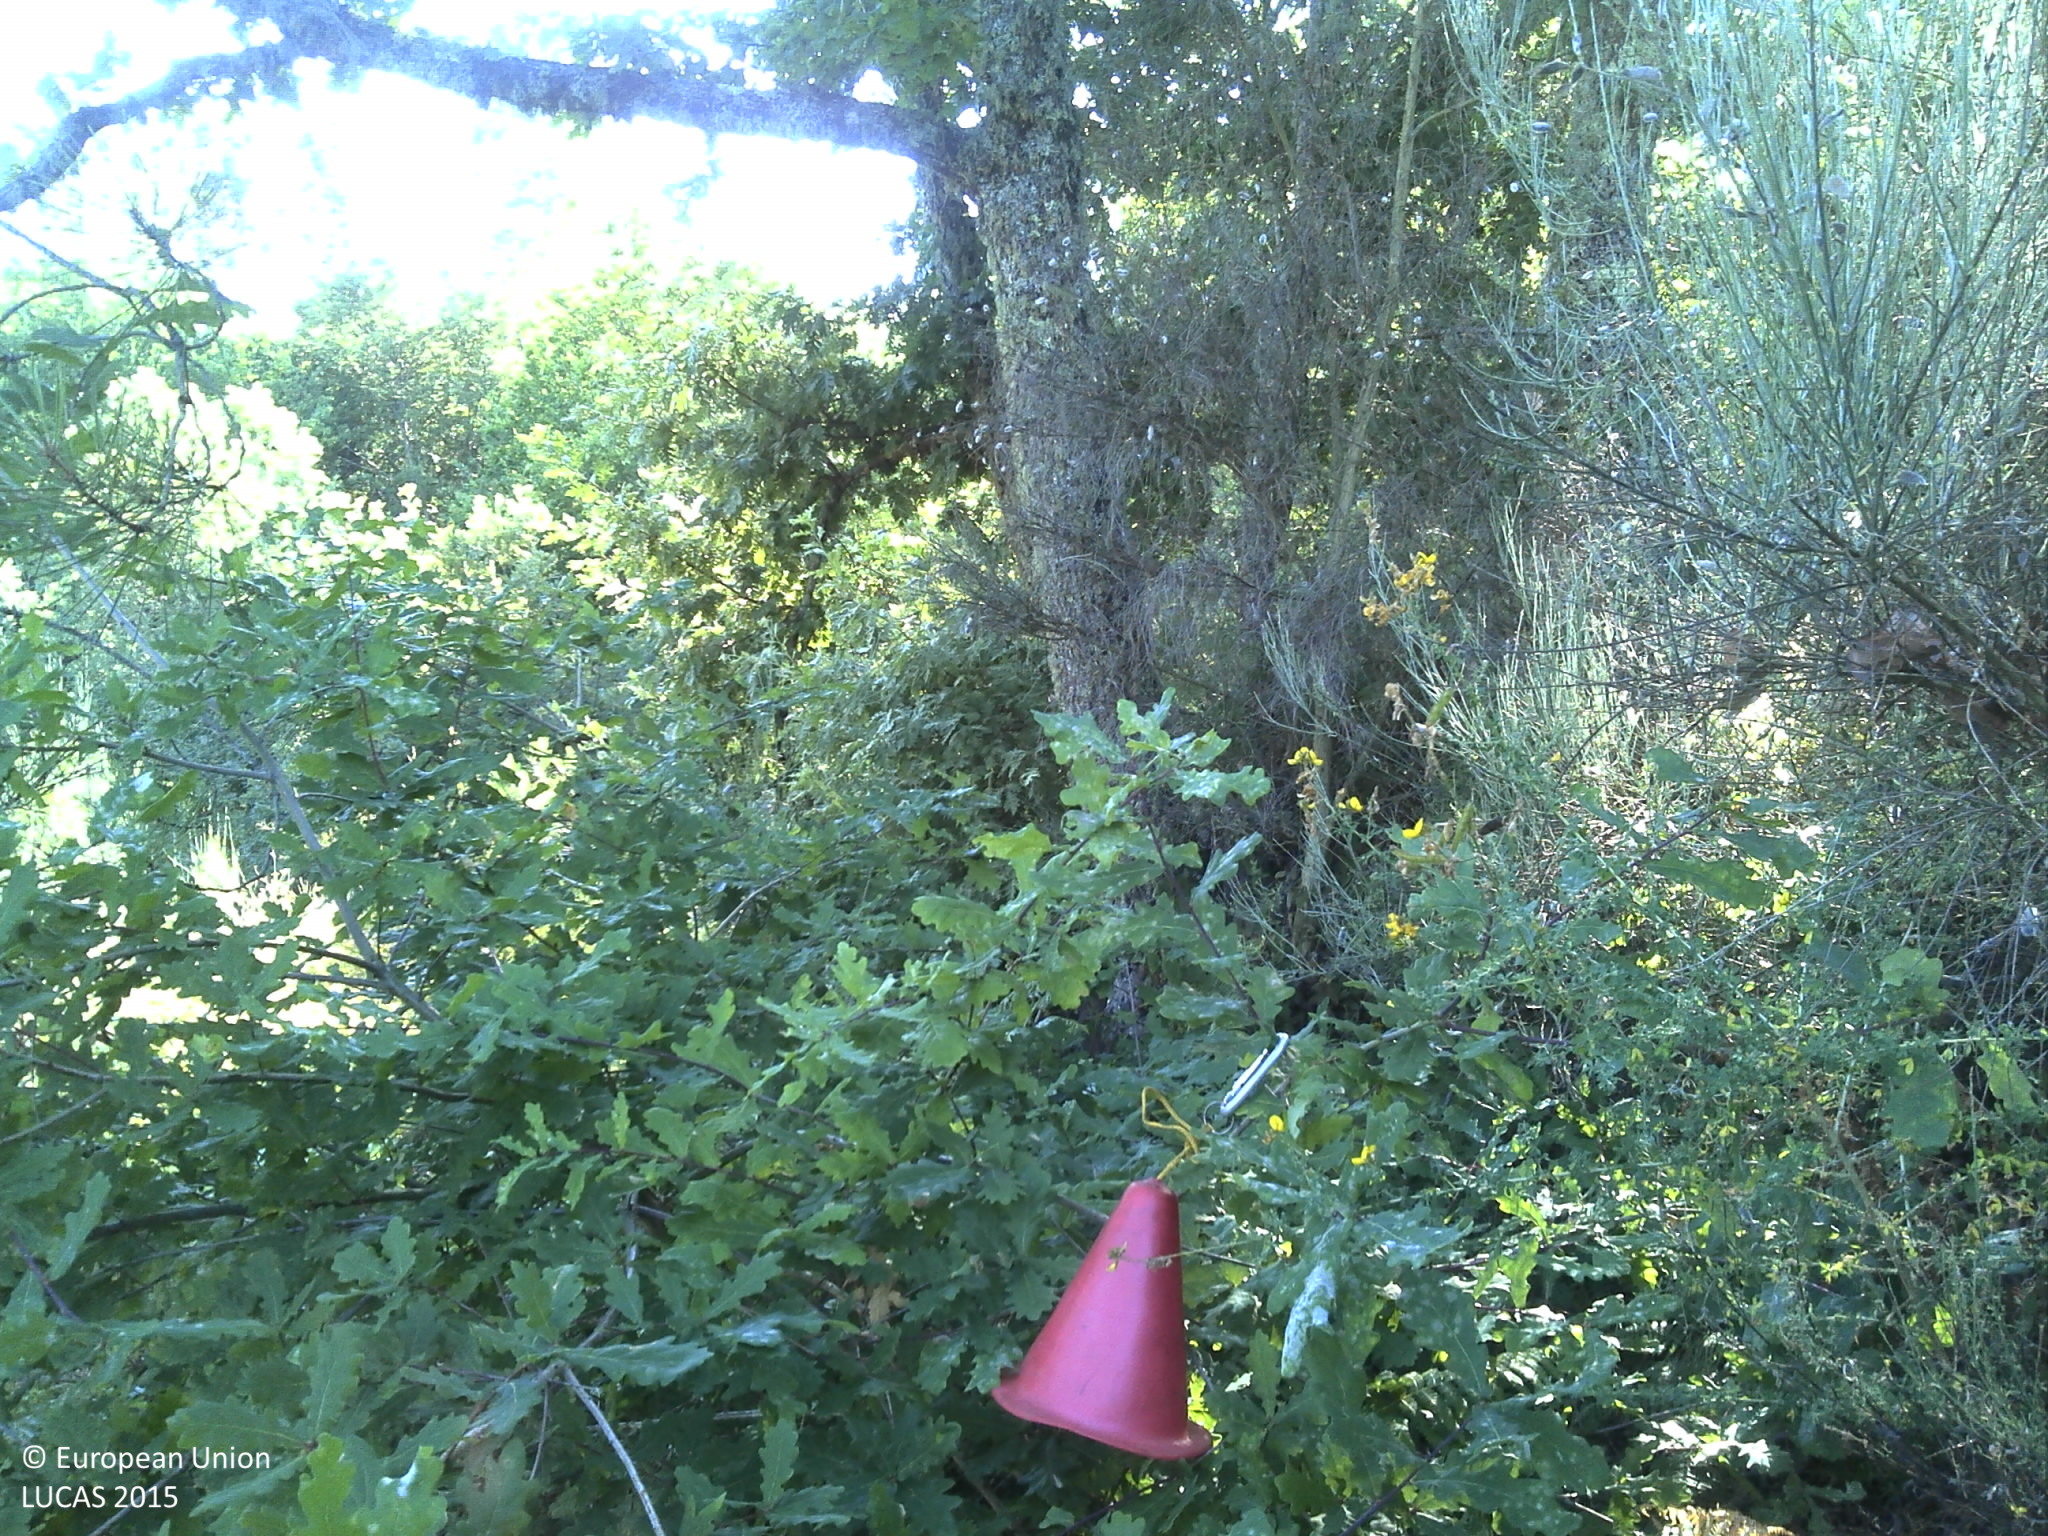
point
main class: Woodland
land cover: Broadleaved woodland
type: thermophilous deciduous forest
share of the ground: > 75 %
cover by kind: broadleaved forest trees 75 %, shrubs 10 %, unconsolidated bare surface 10 %, herbaceous plants 5 %
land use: Forestry
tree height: > 5 m
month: July
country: PT
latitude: 41.6260
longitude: -7.7438
